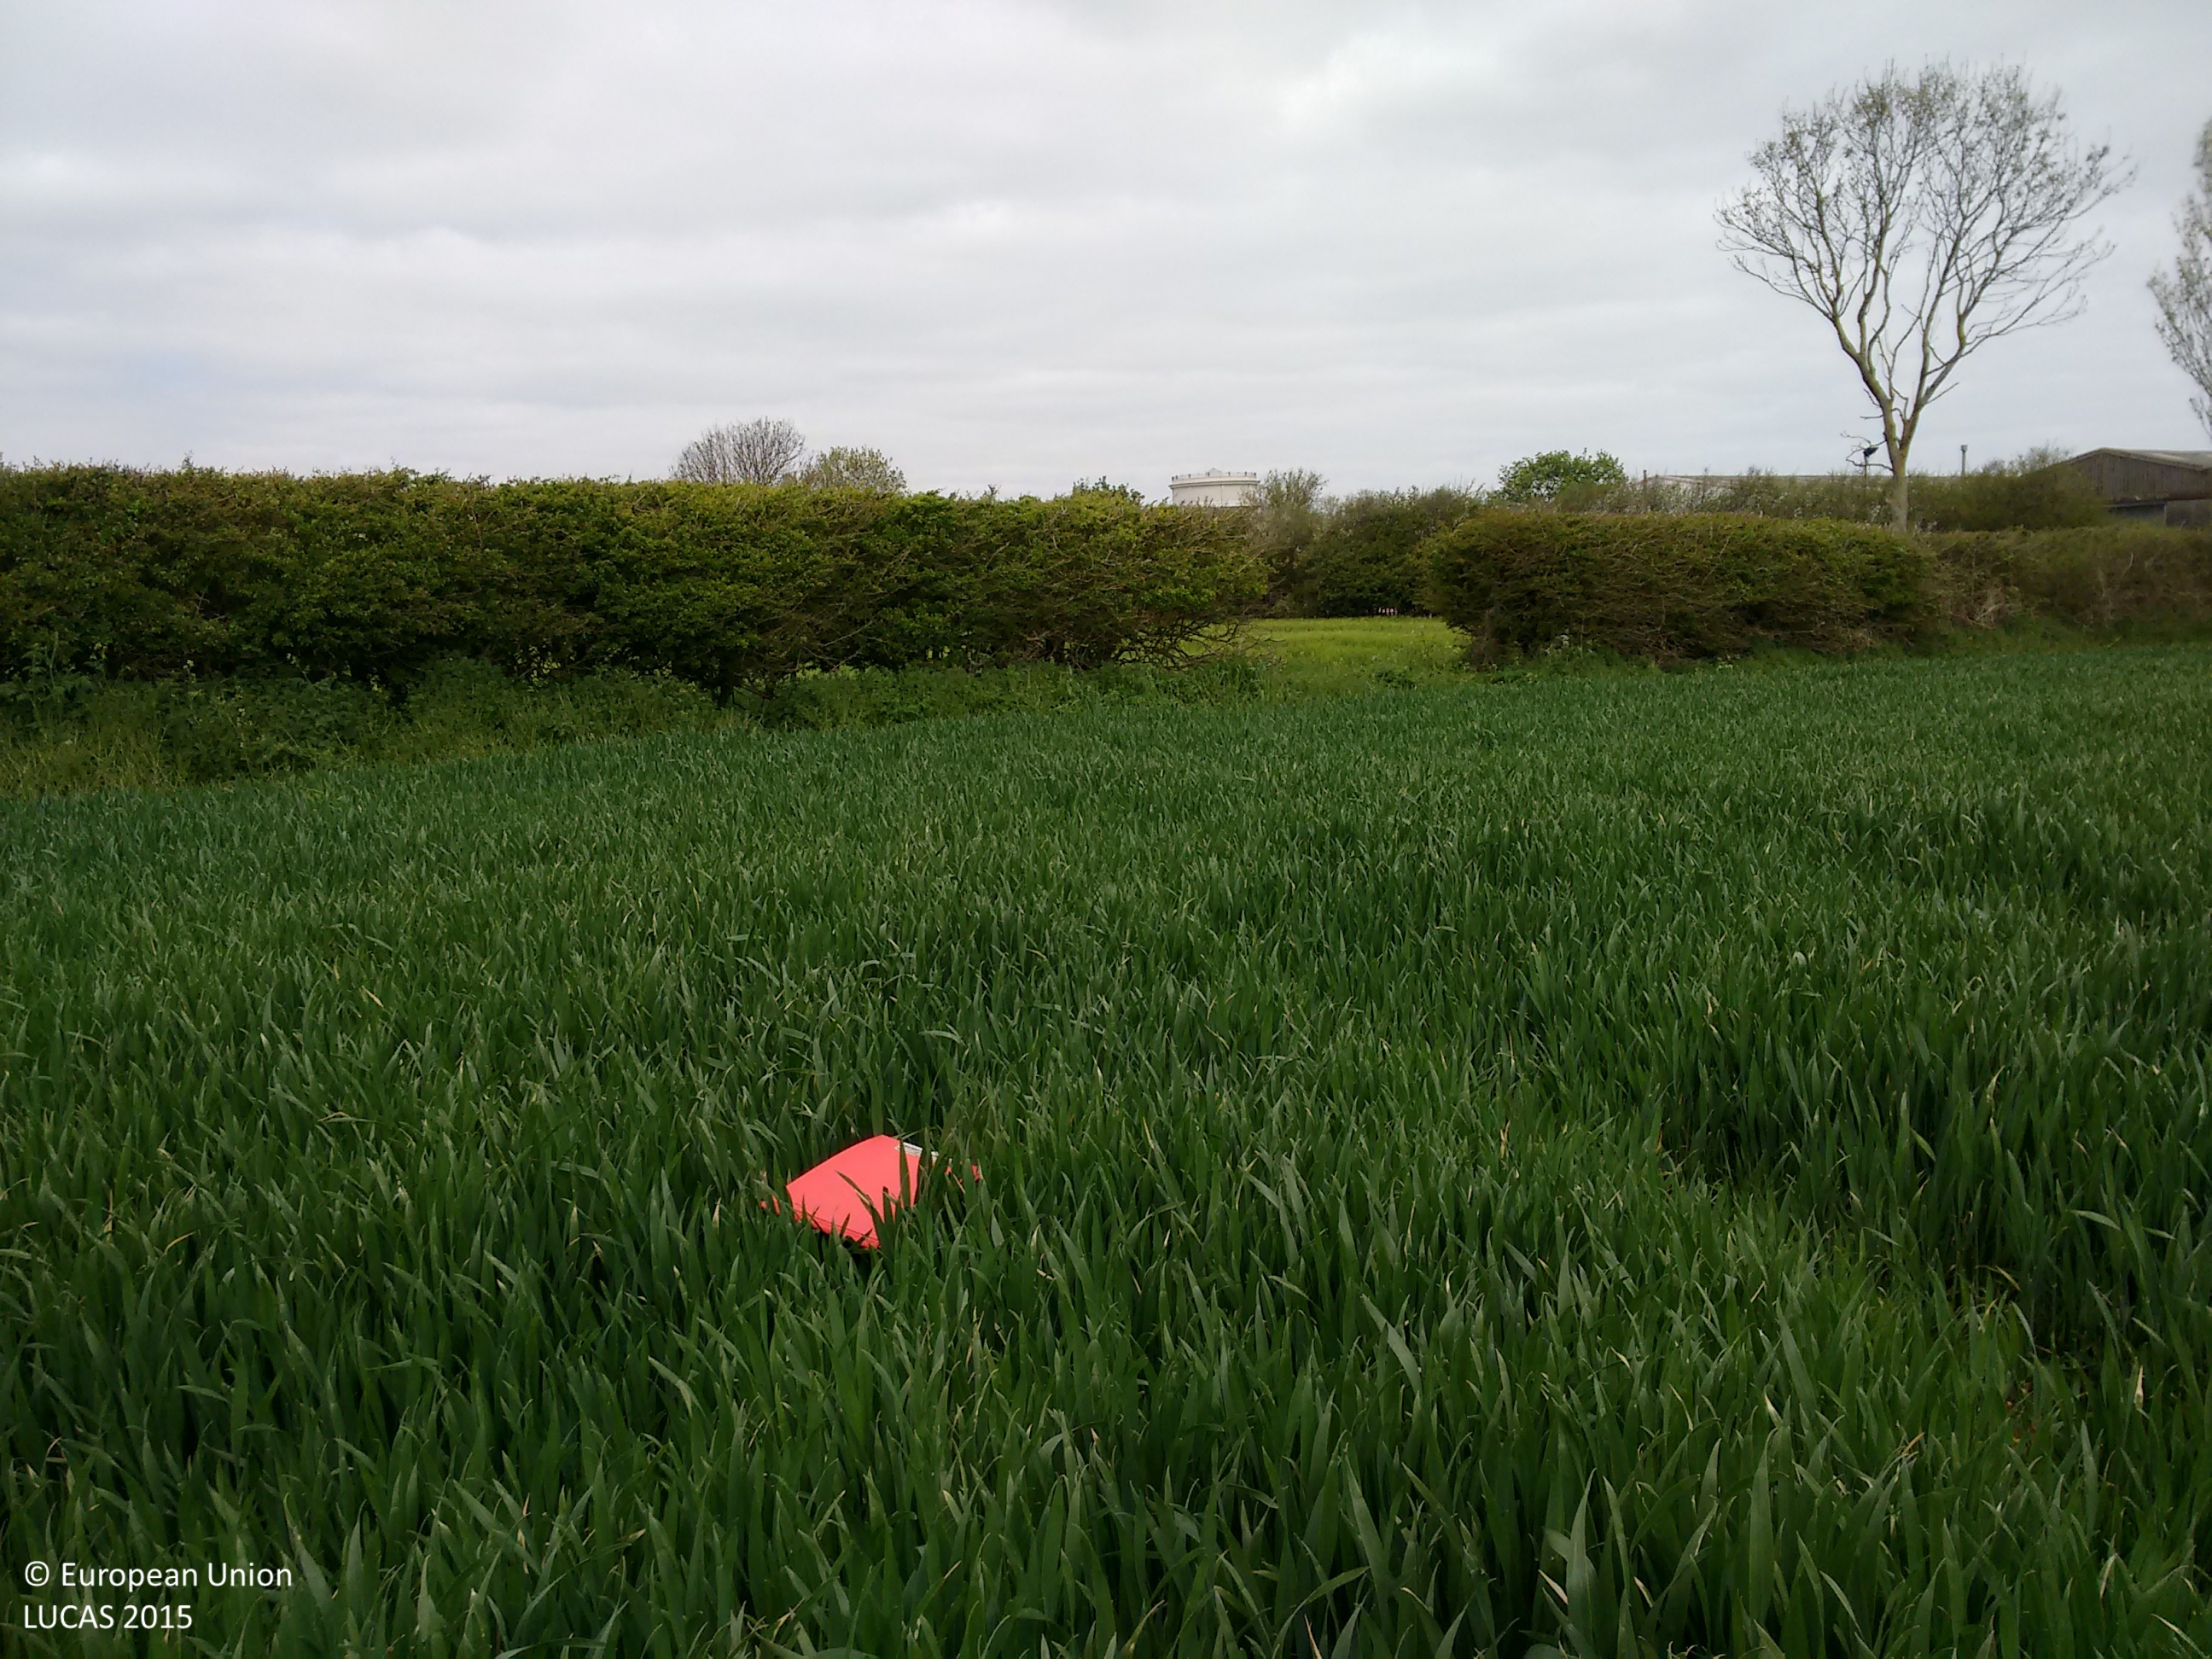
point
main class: Cropland
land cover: Common wheat
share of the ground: > 75 %
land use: Agriculture (excluding fallow land and kitchen gardens)
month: May
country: GB
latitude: 53.7283
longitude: -0.0201
